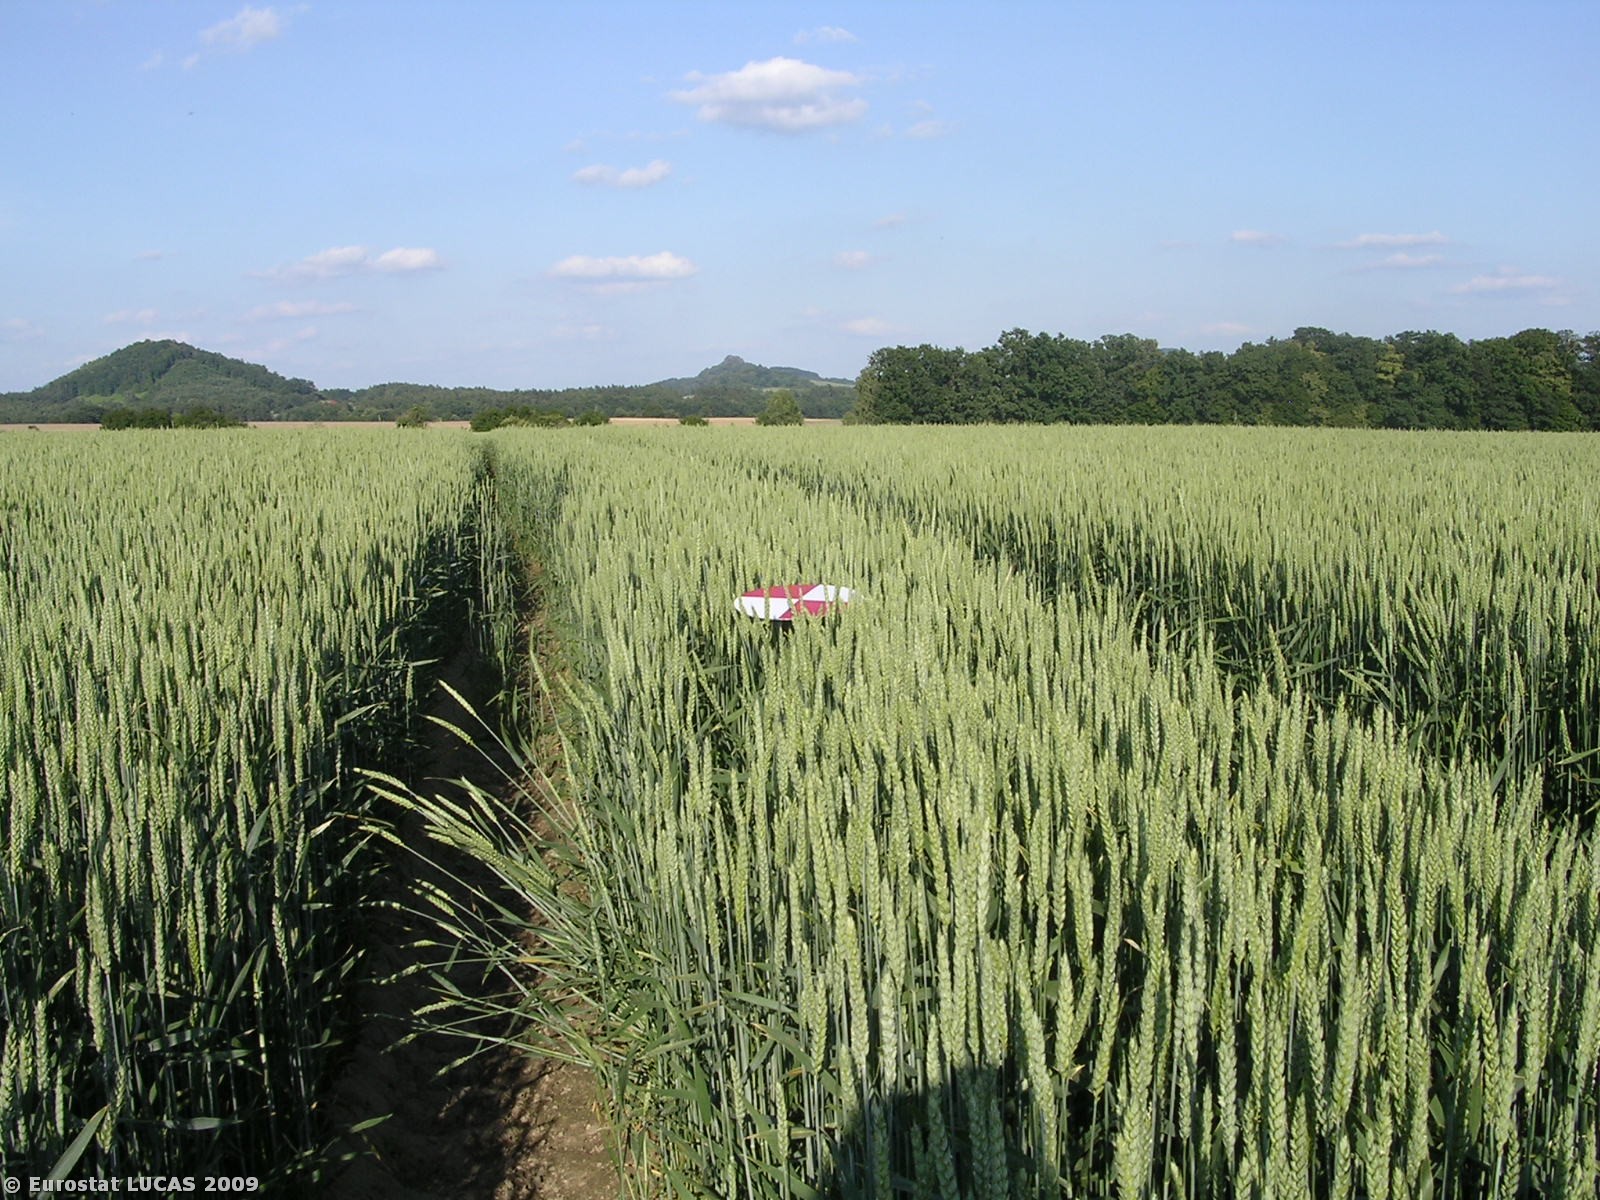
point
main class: Cropland
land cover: Common wheat
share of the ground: > 75 %
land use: Agriculture (excluding fallow land and kitchen gardens)
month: June
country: CZ
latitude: 50.6341
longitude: 14.5404
